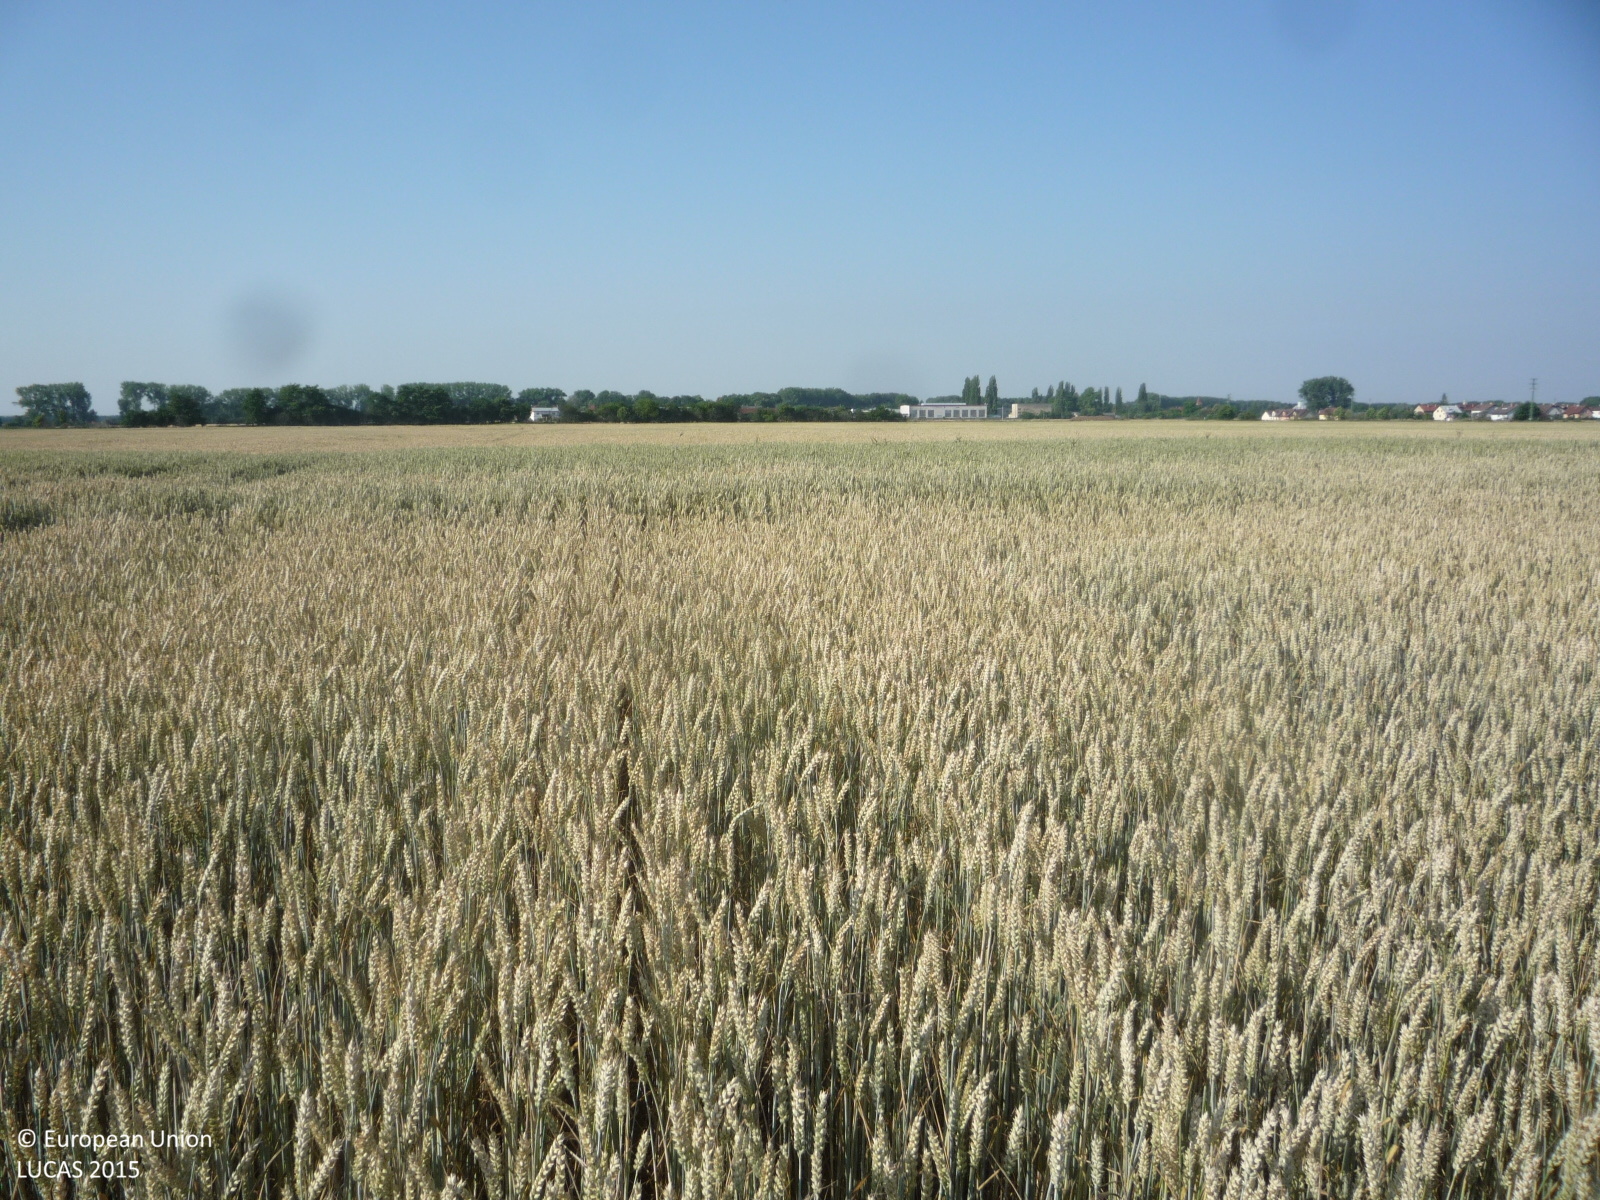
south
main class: Cropland
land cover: Common wheat
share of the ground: > 75 %
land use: Agriculture (excluding fallow land and kitchen gardens)
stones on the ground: < 10 %
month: July
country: CZ
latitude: 50.1380
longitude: 15.1940
